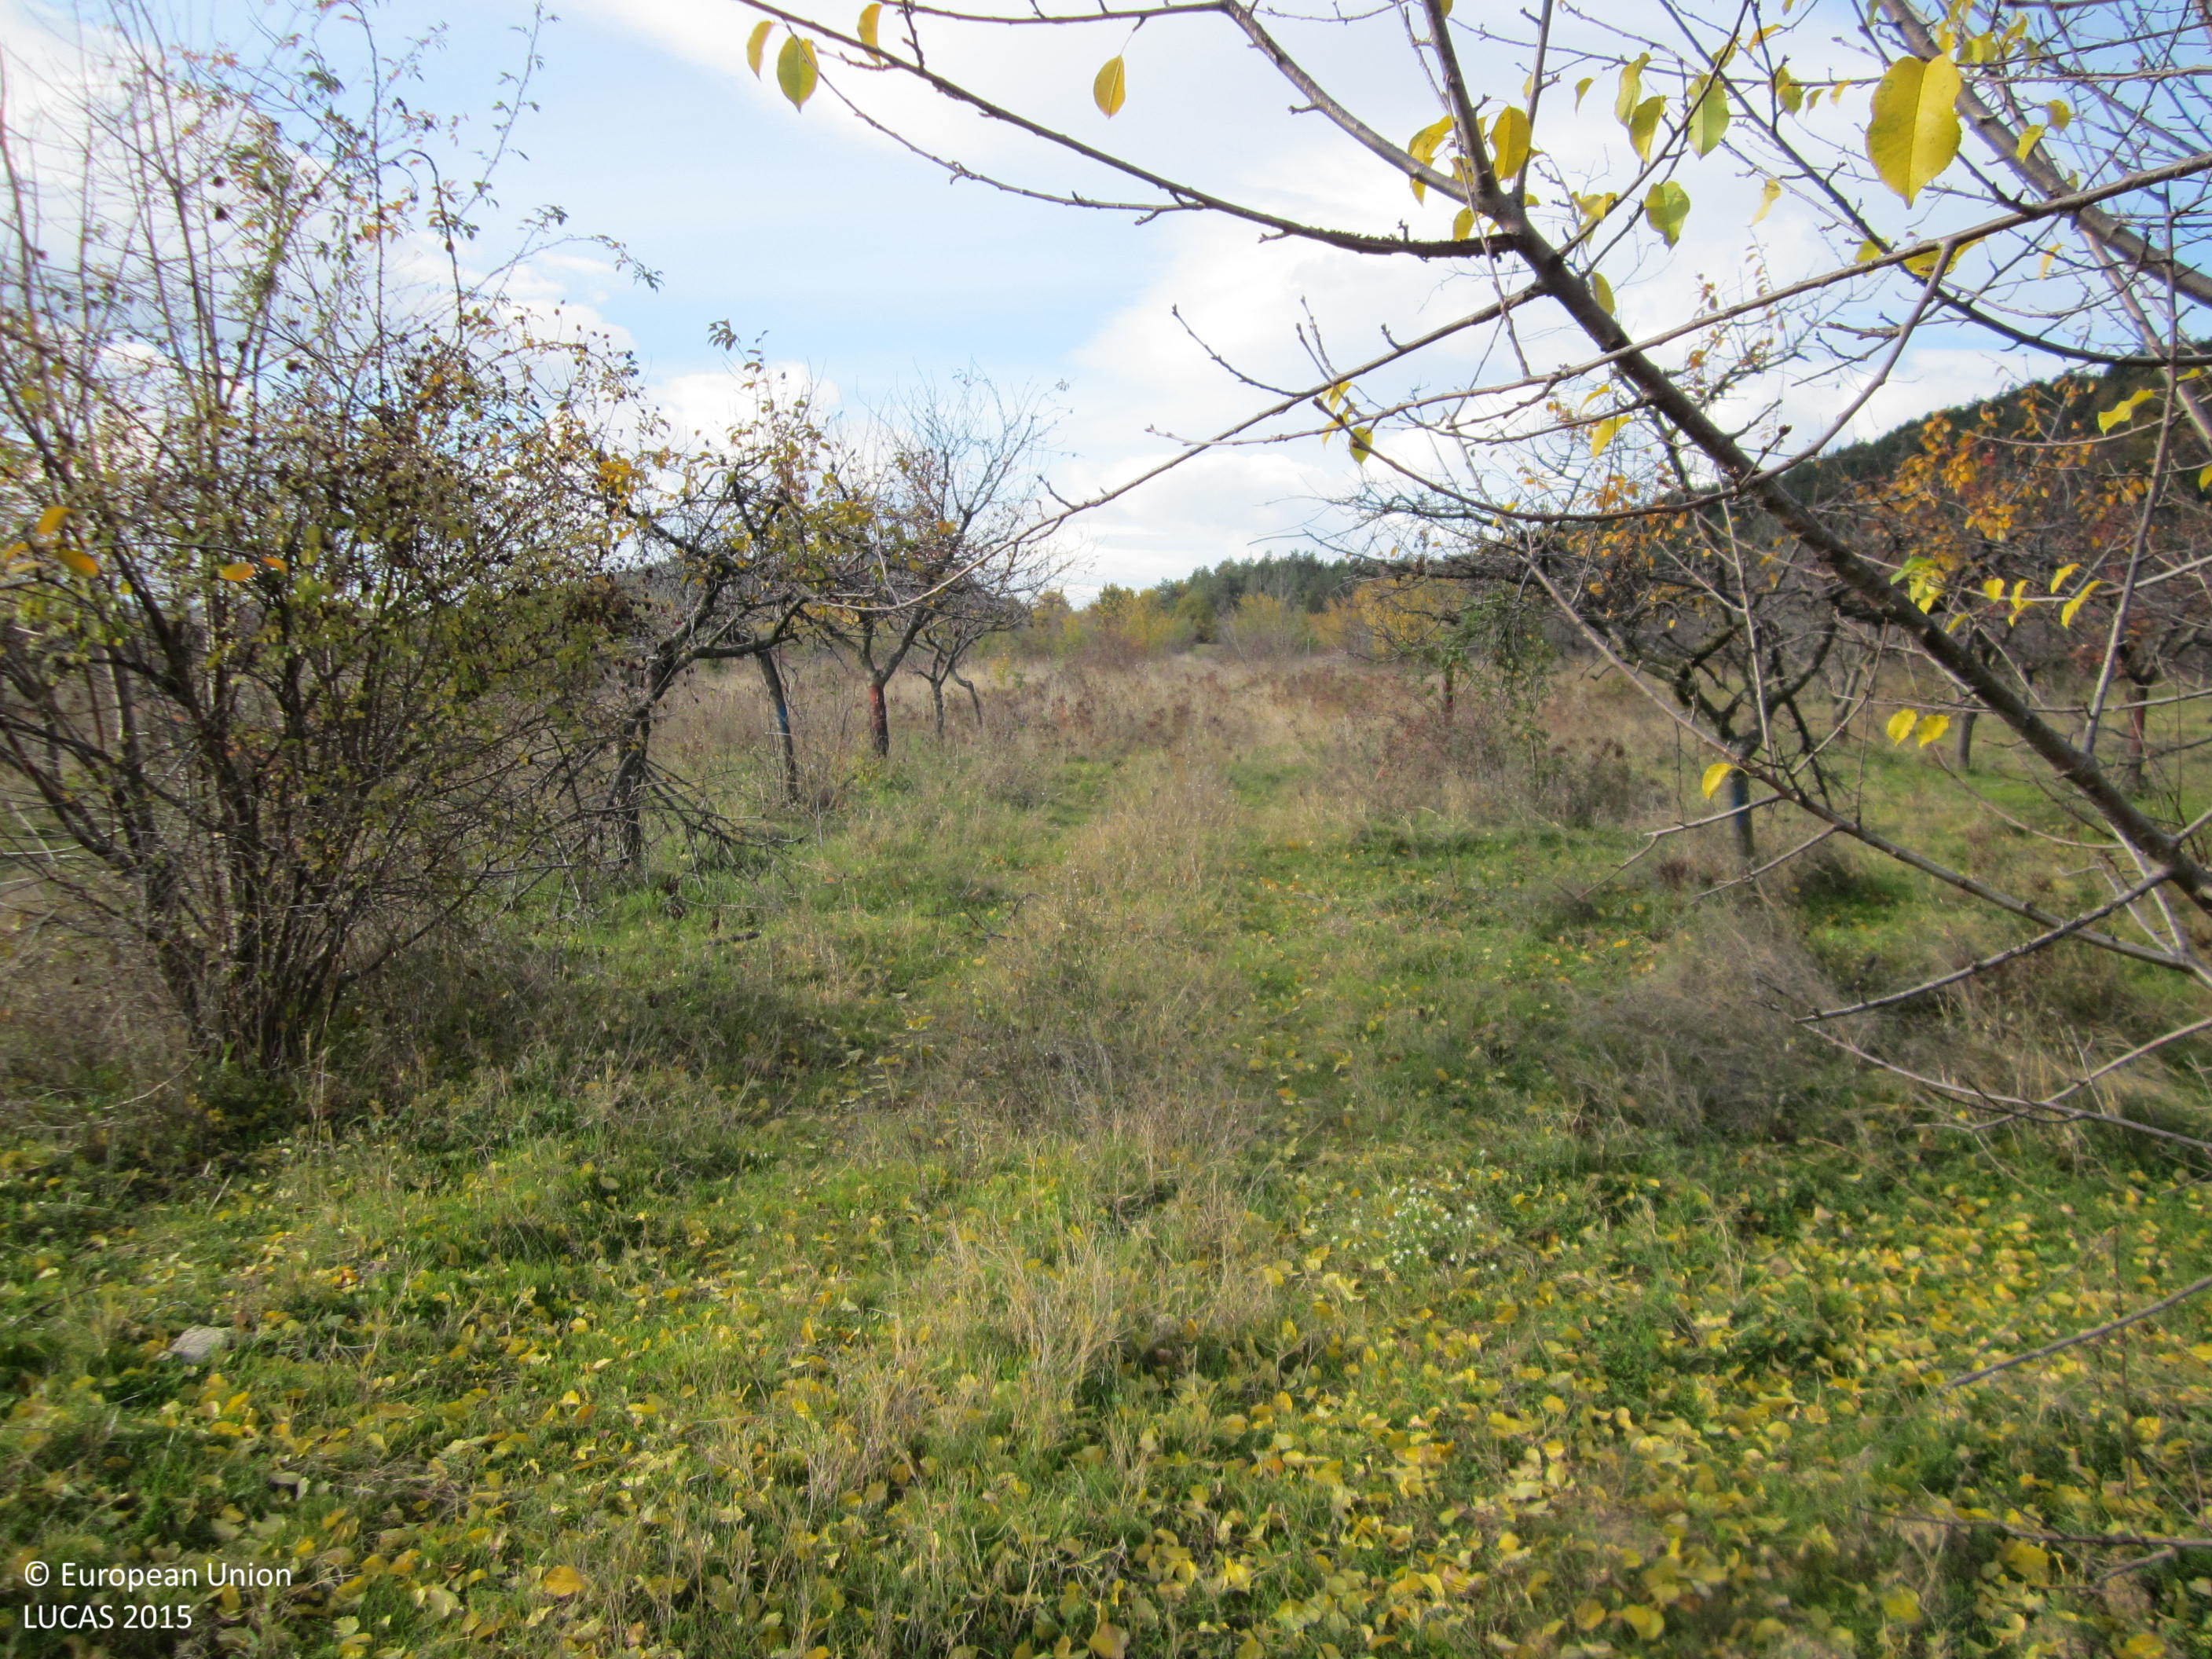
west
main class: Cropland
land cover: Cherry fruit
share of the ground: 50 - 75 %
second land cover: Grassland without tree/shrub cover
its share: > 75 %
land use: Agriculture (excluding fallow land and kitchen gardens)
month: November
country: BG
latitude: 42.5276
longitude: 24.7001
